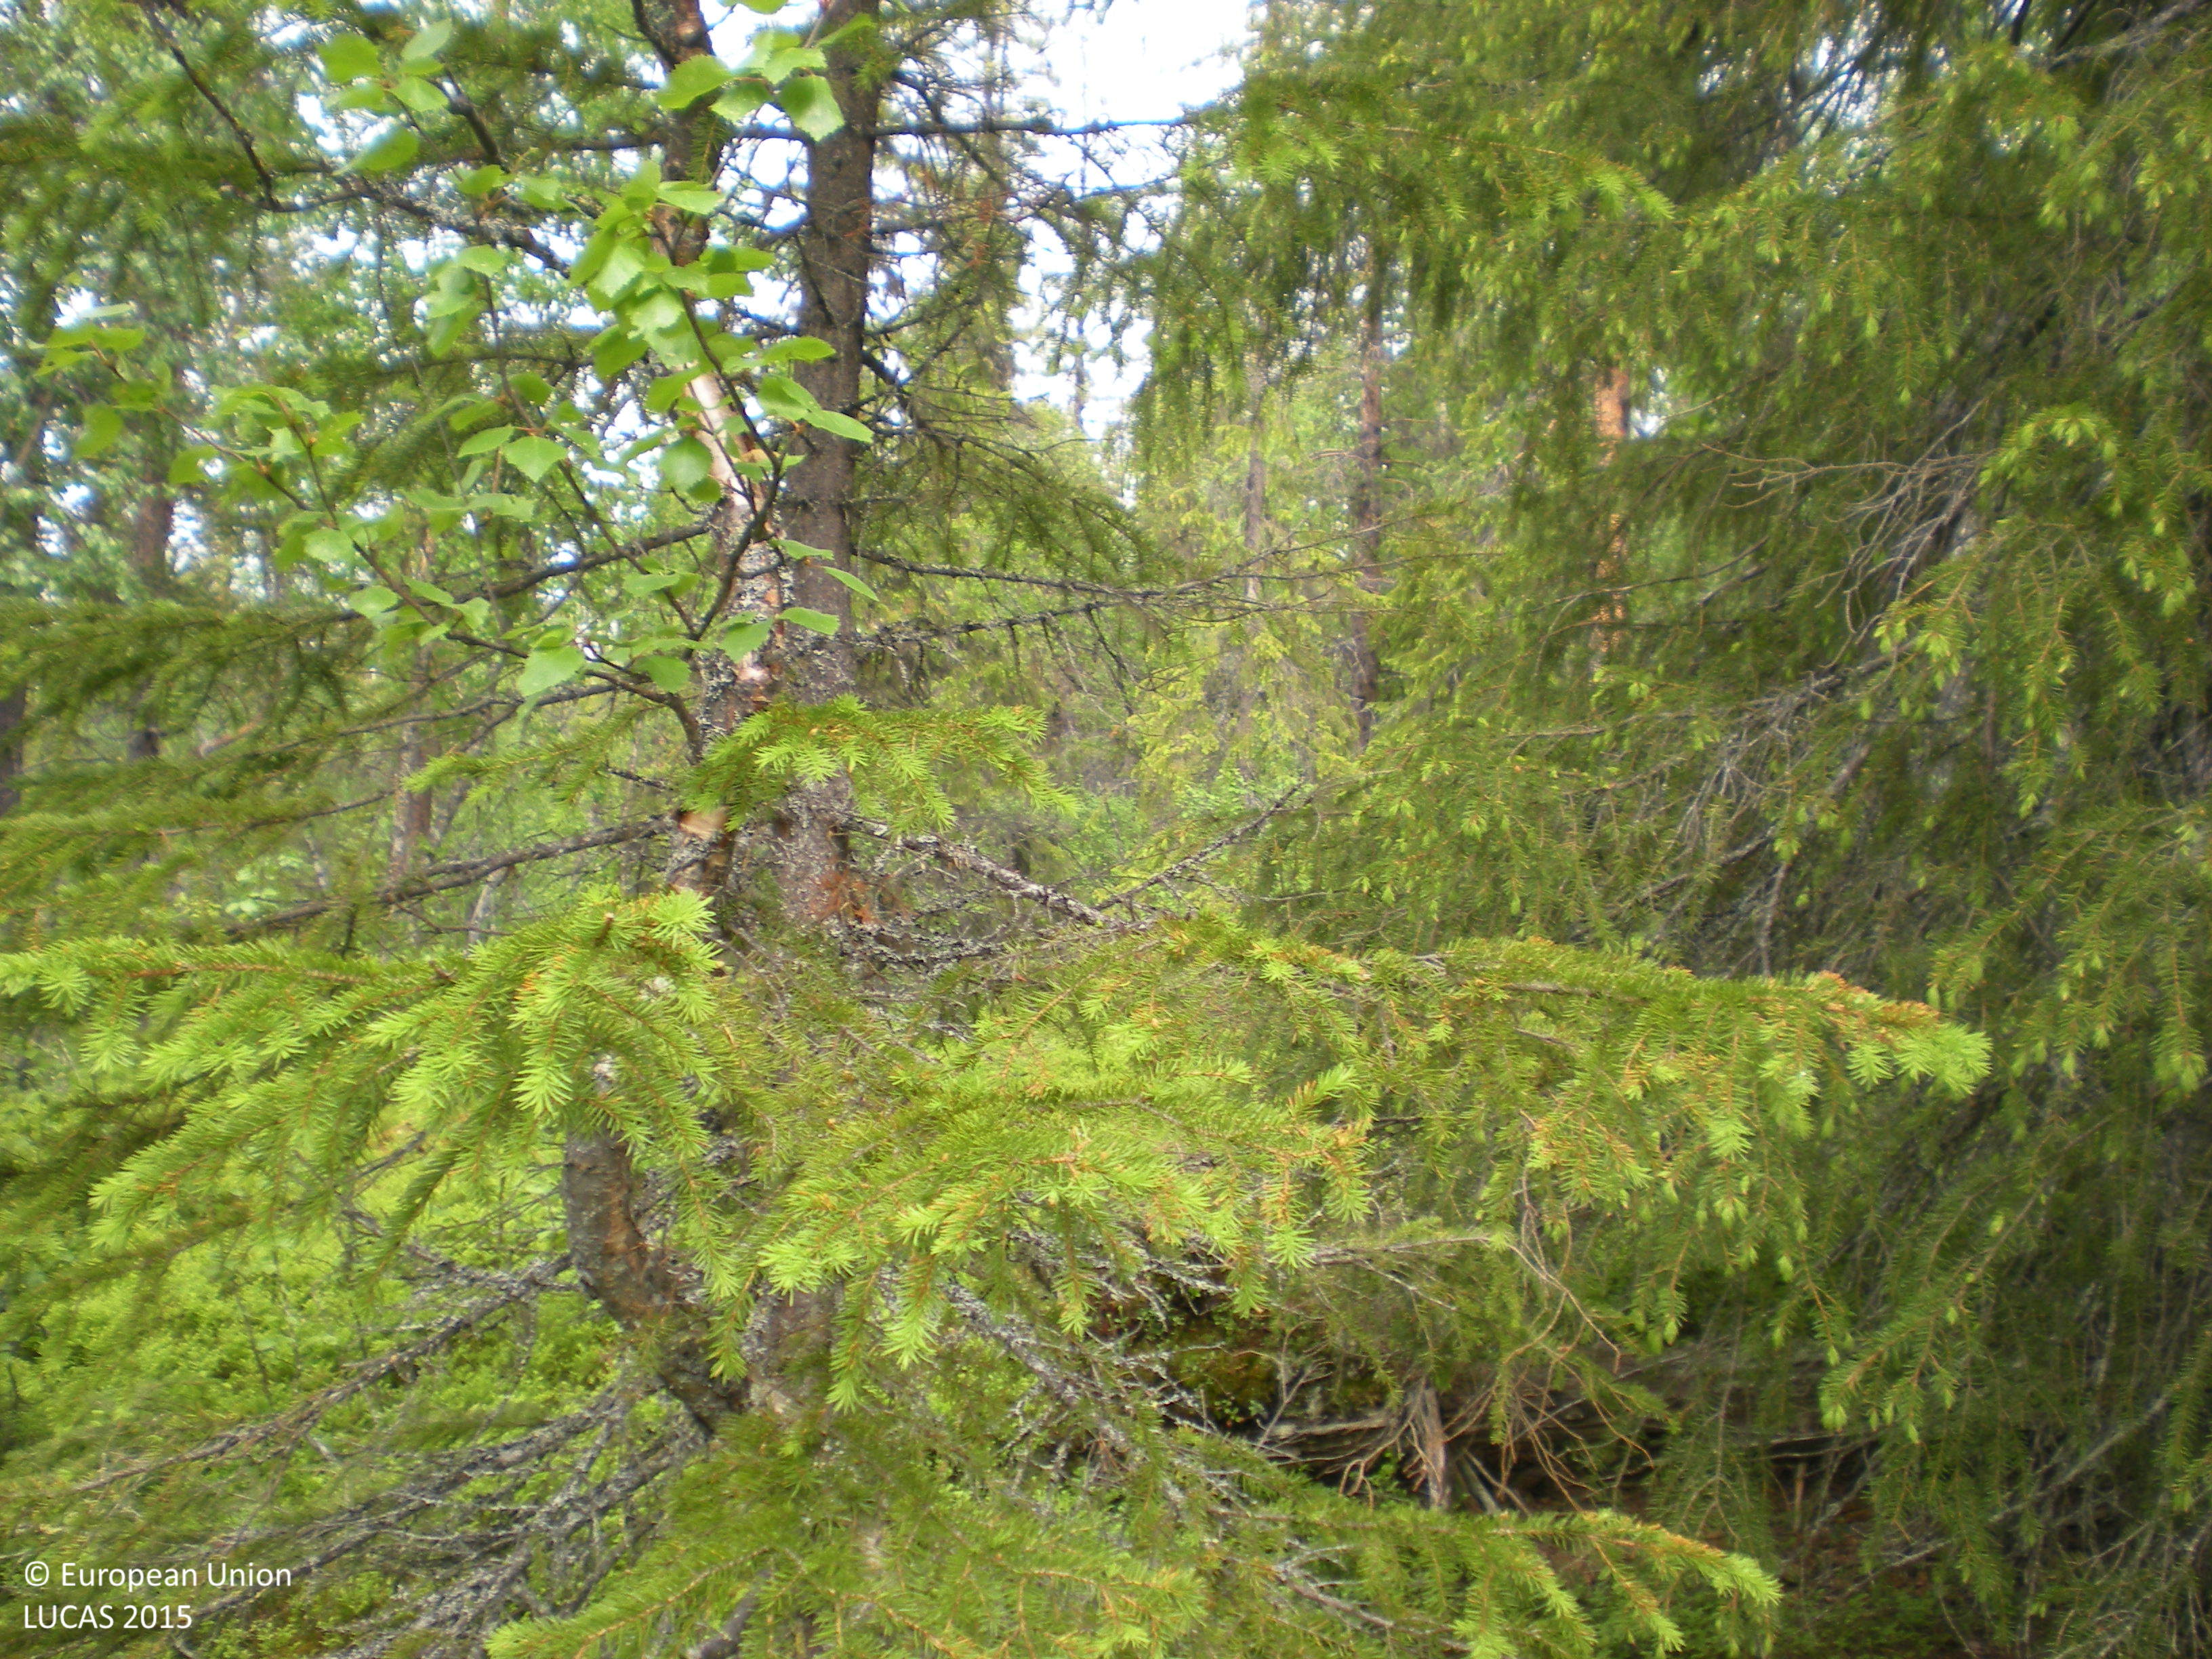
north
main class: Woodland
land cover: Other mixed woodland
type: boreal forest
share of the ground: 50 - 75 %
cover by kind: coniferous forest trees 50 %, broadleaved forest trees 20 %, shrubs 20 %, lichens and mosses 10 %
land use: Forestry
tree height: > 5 m
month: July
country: SE
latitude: 66.1611
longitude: 17.1615
